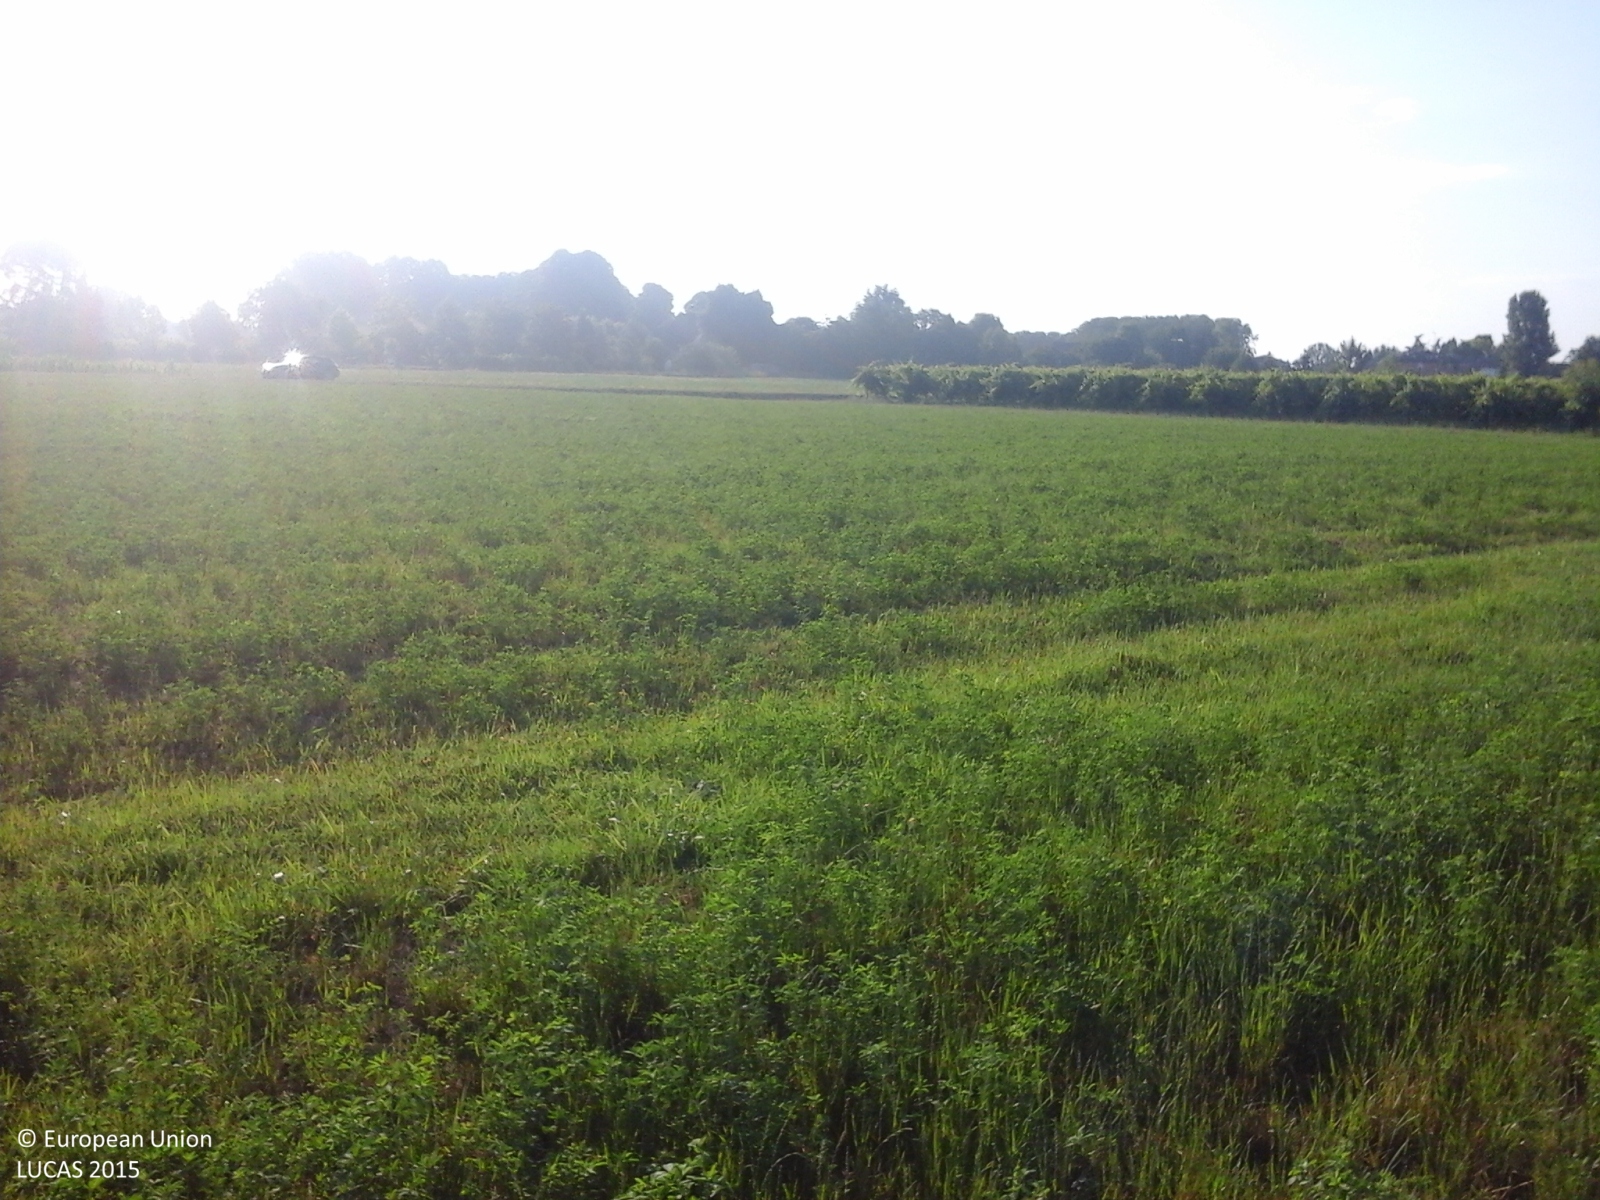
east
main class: Cropland
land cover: Lucerne
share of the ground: > 75 %
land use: Agriculture (excluding fallow land and kitchen gardens)
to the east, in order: Lucerne; Grass margins; Ditches and canals; Grass margins; Paved roads, cycling and walking lanes; Grass margins; Ditches and canals; Grass margins; Lucerne; Ditches and canals; Grassland without tree/shrub cover; Vineyards; Nuts trees
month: June
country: IT
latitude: 44.9231
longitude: 10.9736
